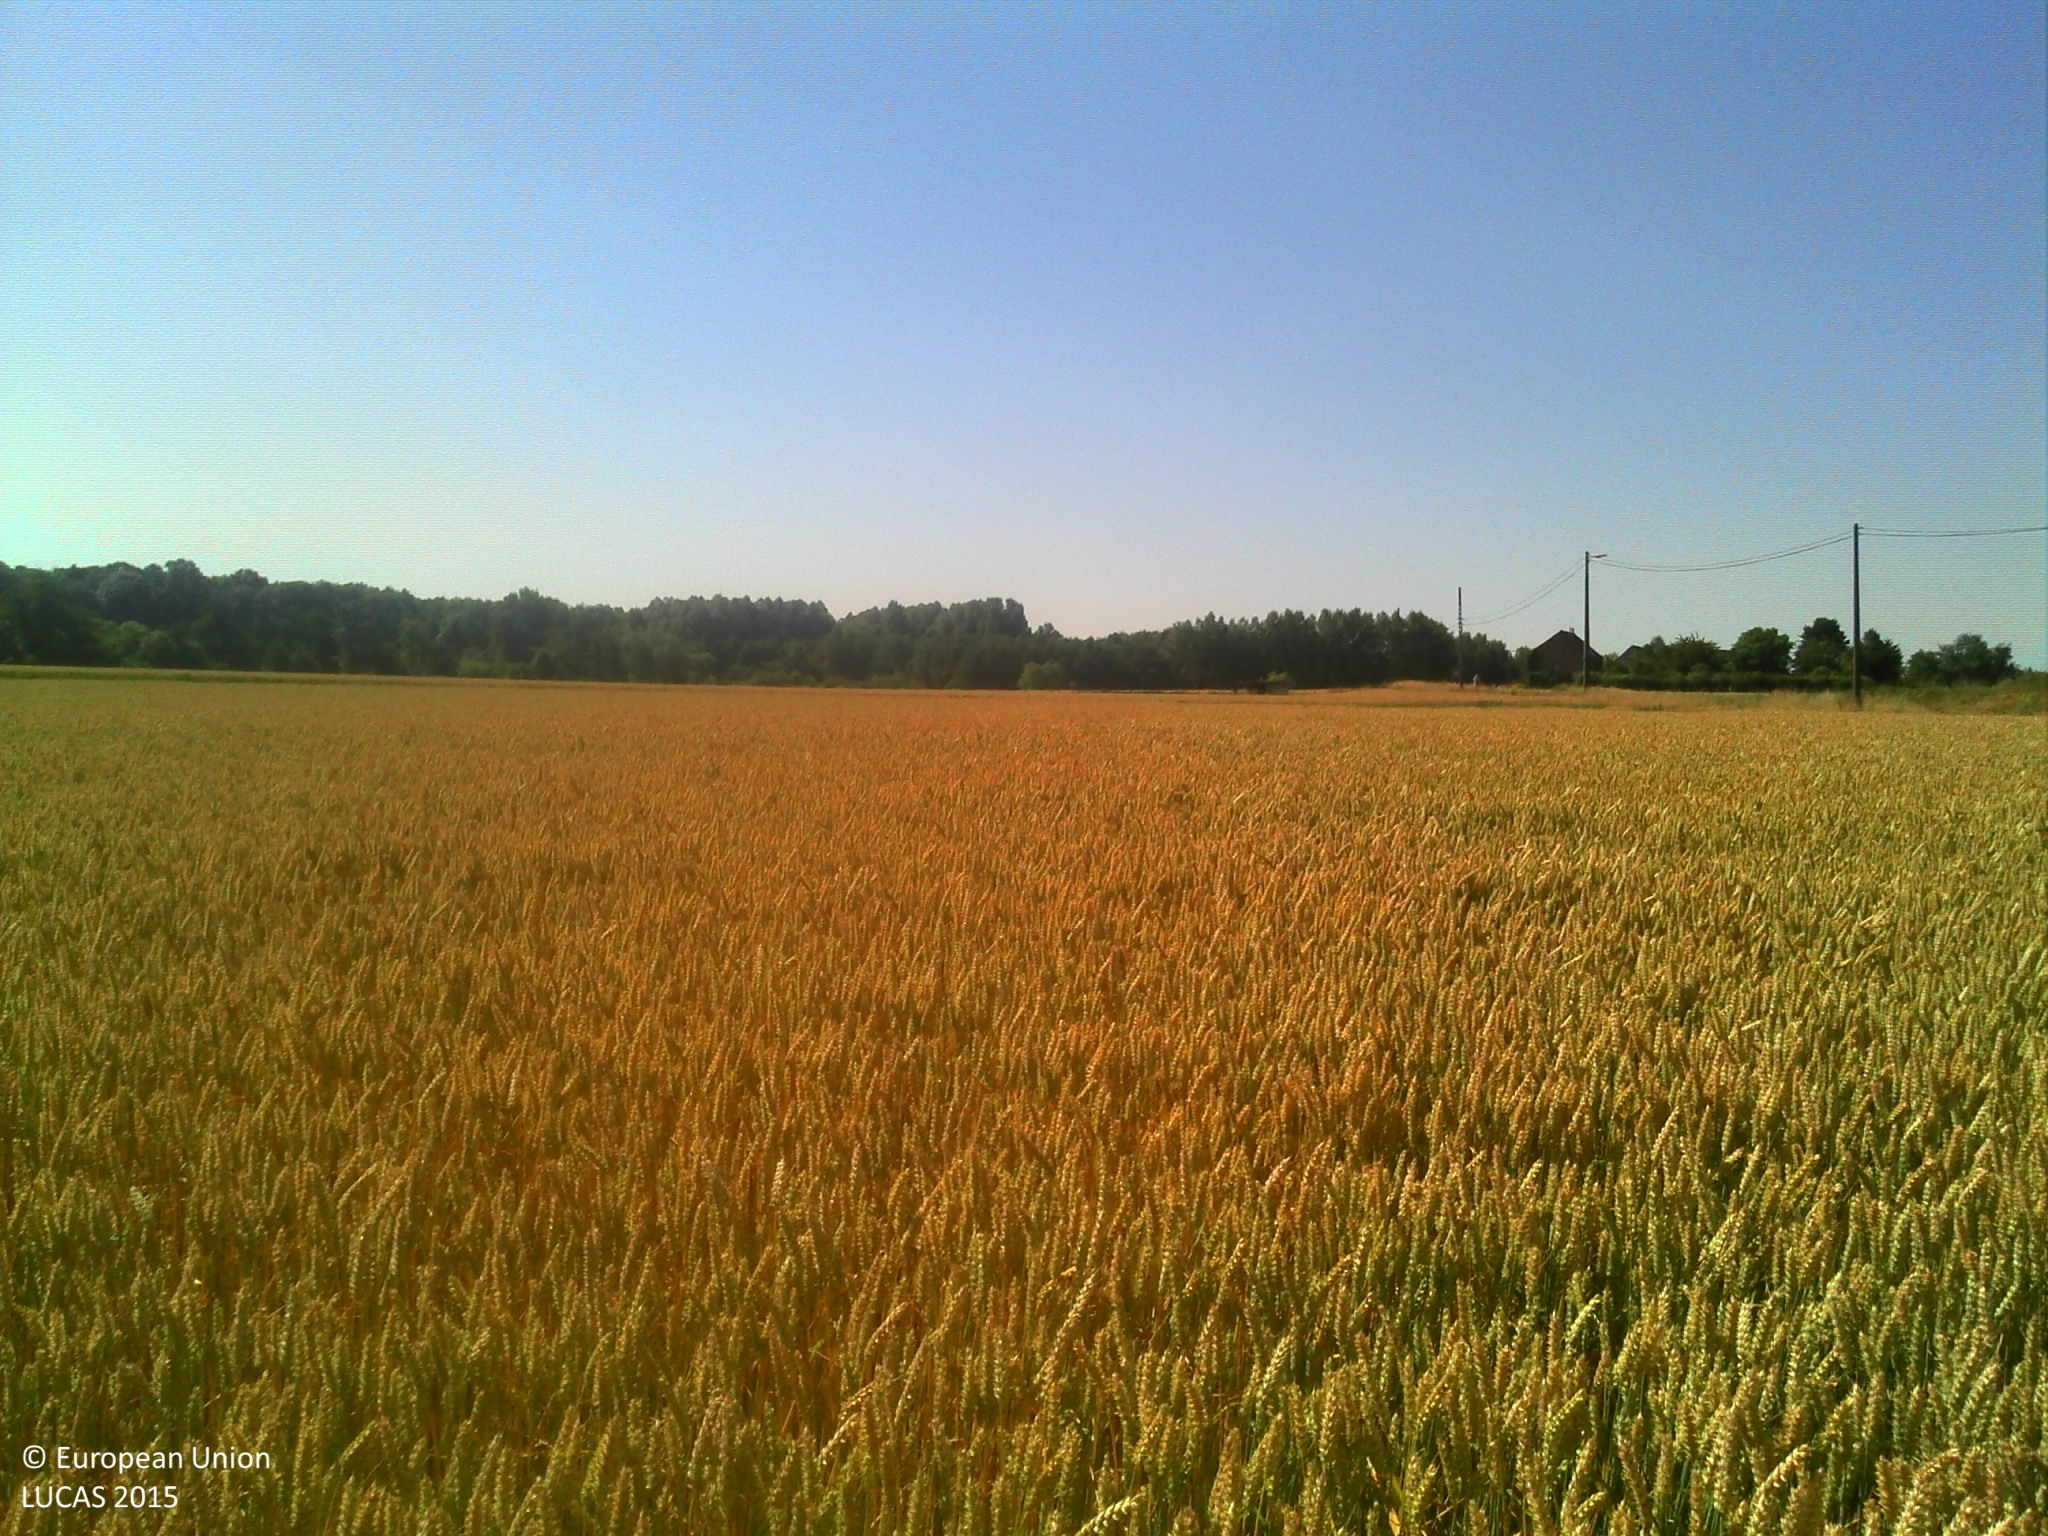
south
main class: Cropland
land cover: Common wheat
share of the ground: > 75 %
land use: Agriculture (excluding fallow land and kitchen gardens)
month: July
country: BE
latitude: 50.8205
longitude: 4.7586
